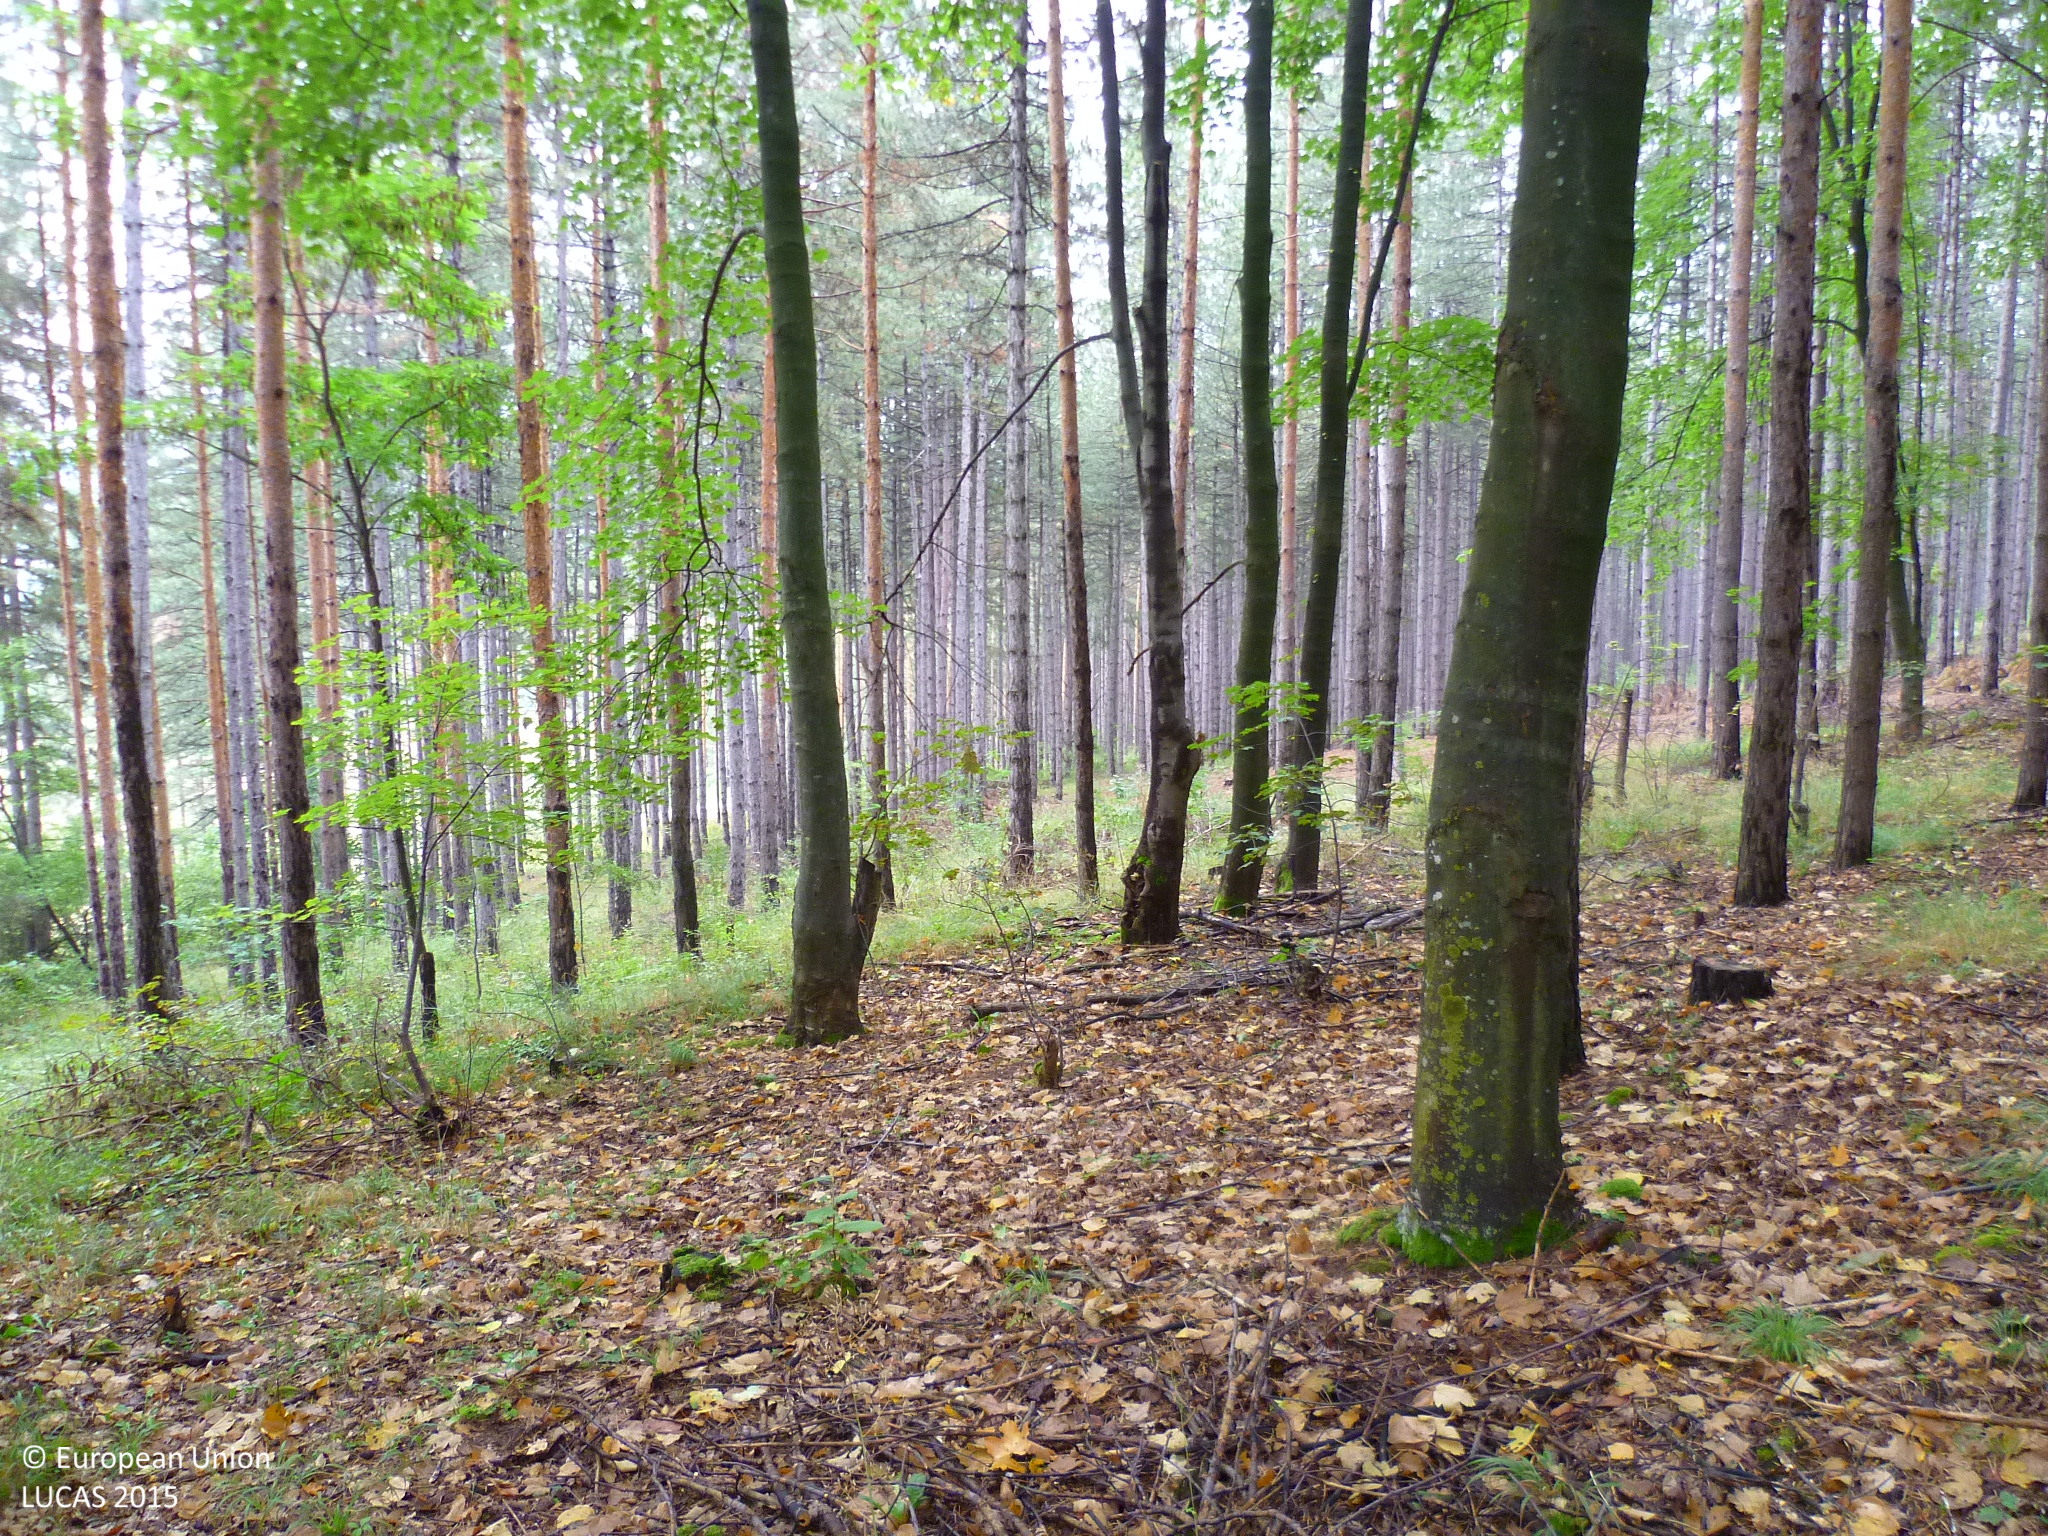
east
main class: Woodland
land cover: Pine dominated mixed woodland
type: alpine coniferous forest
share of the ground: 50 - 75 %
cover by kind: coniferous forest trees 50 %, broadleaved forest trees 30 %, unconsolidated bare surface 10 %, shrubs 5 %, herbaceous plants 5 %
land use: Forestry
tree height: > 5 m
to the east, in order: Pine dominated mixed woodland; Ditches and canals; Pine dominated mixed woodland; Pine dominated coniferous woodland; Grassland without tree/shrub cover; Shrubland without tree cover; Grassland without tree/shrub cover; Tracks; Grassland without tree/shrub cover; Broadleaved woodland; Grassland without tree/shrub cover
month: September
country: BG
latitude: 42.7573
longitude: 22.8953
